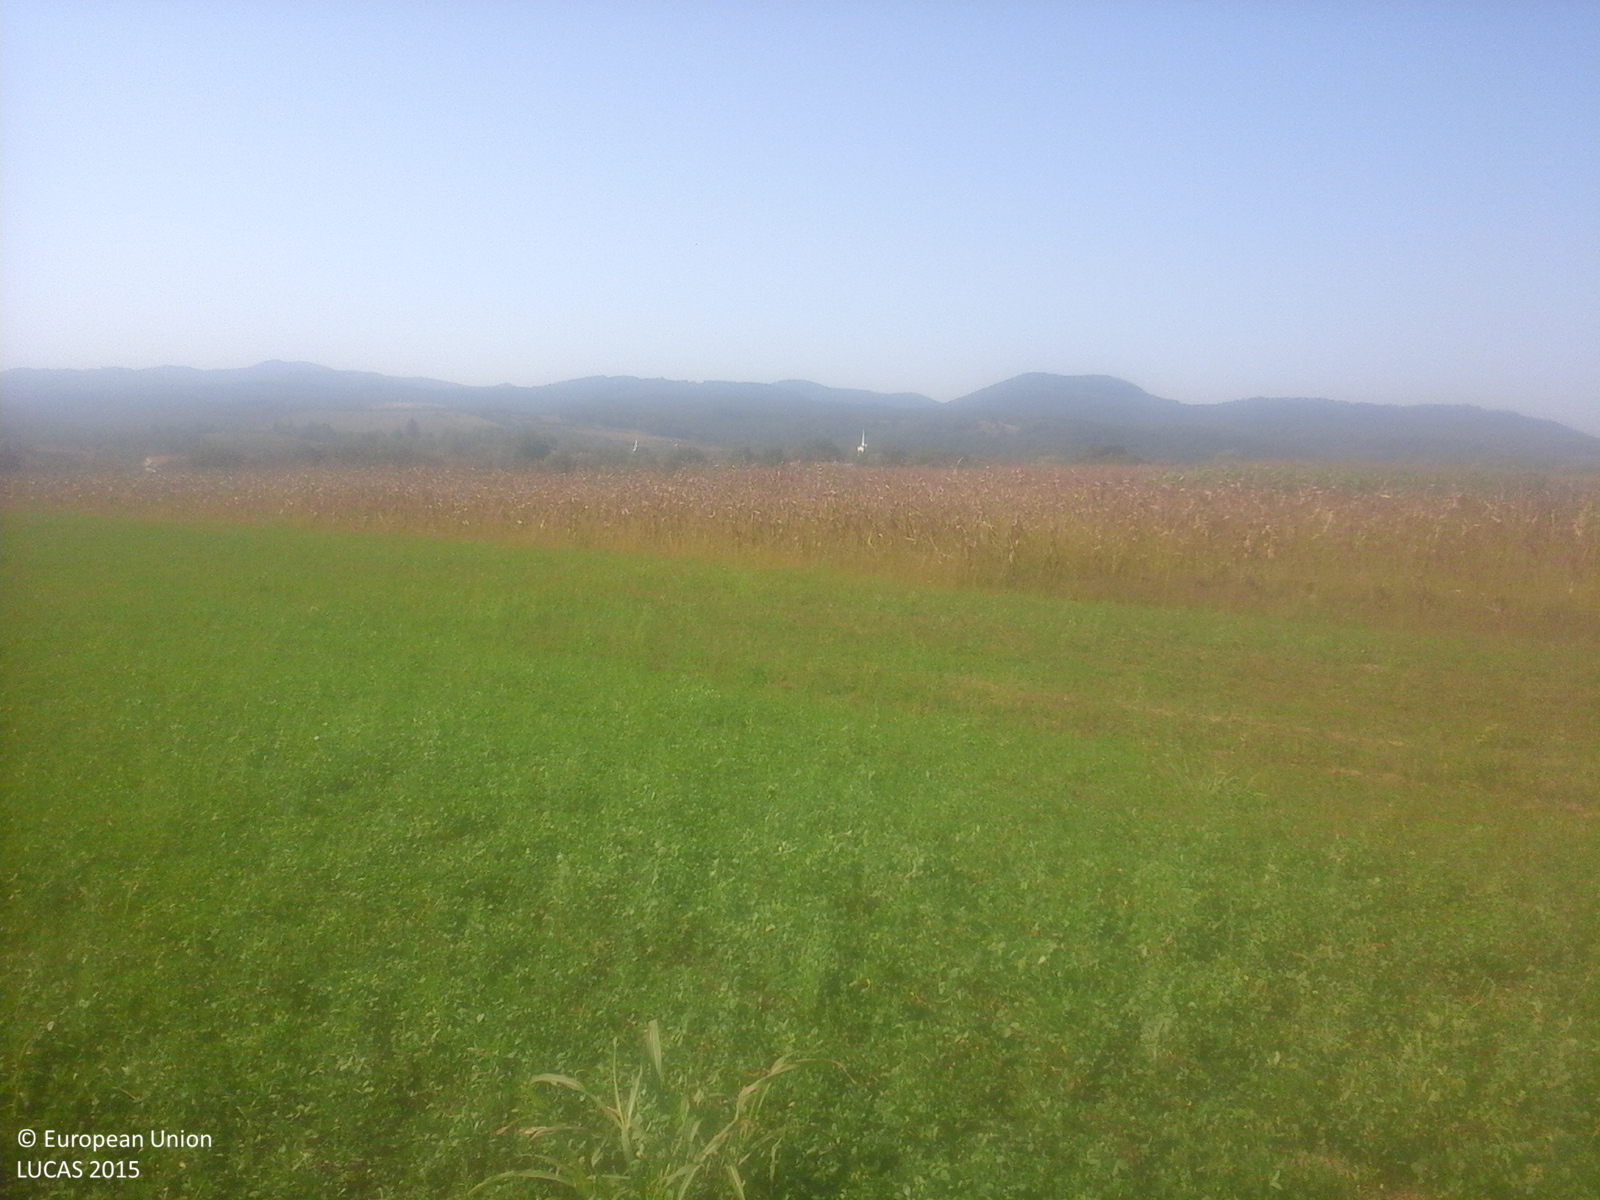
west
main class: Cropland
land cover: Lucerne
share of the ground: > 75 %
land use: Agriculture (excluding fallow land and kitchen gardens)
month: September
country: RO
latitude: 46.6793
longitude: 22.2726
